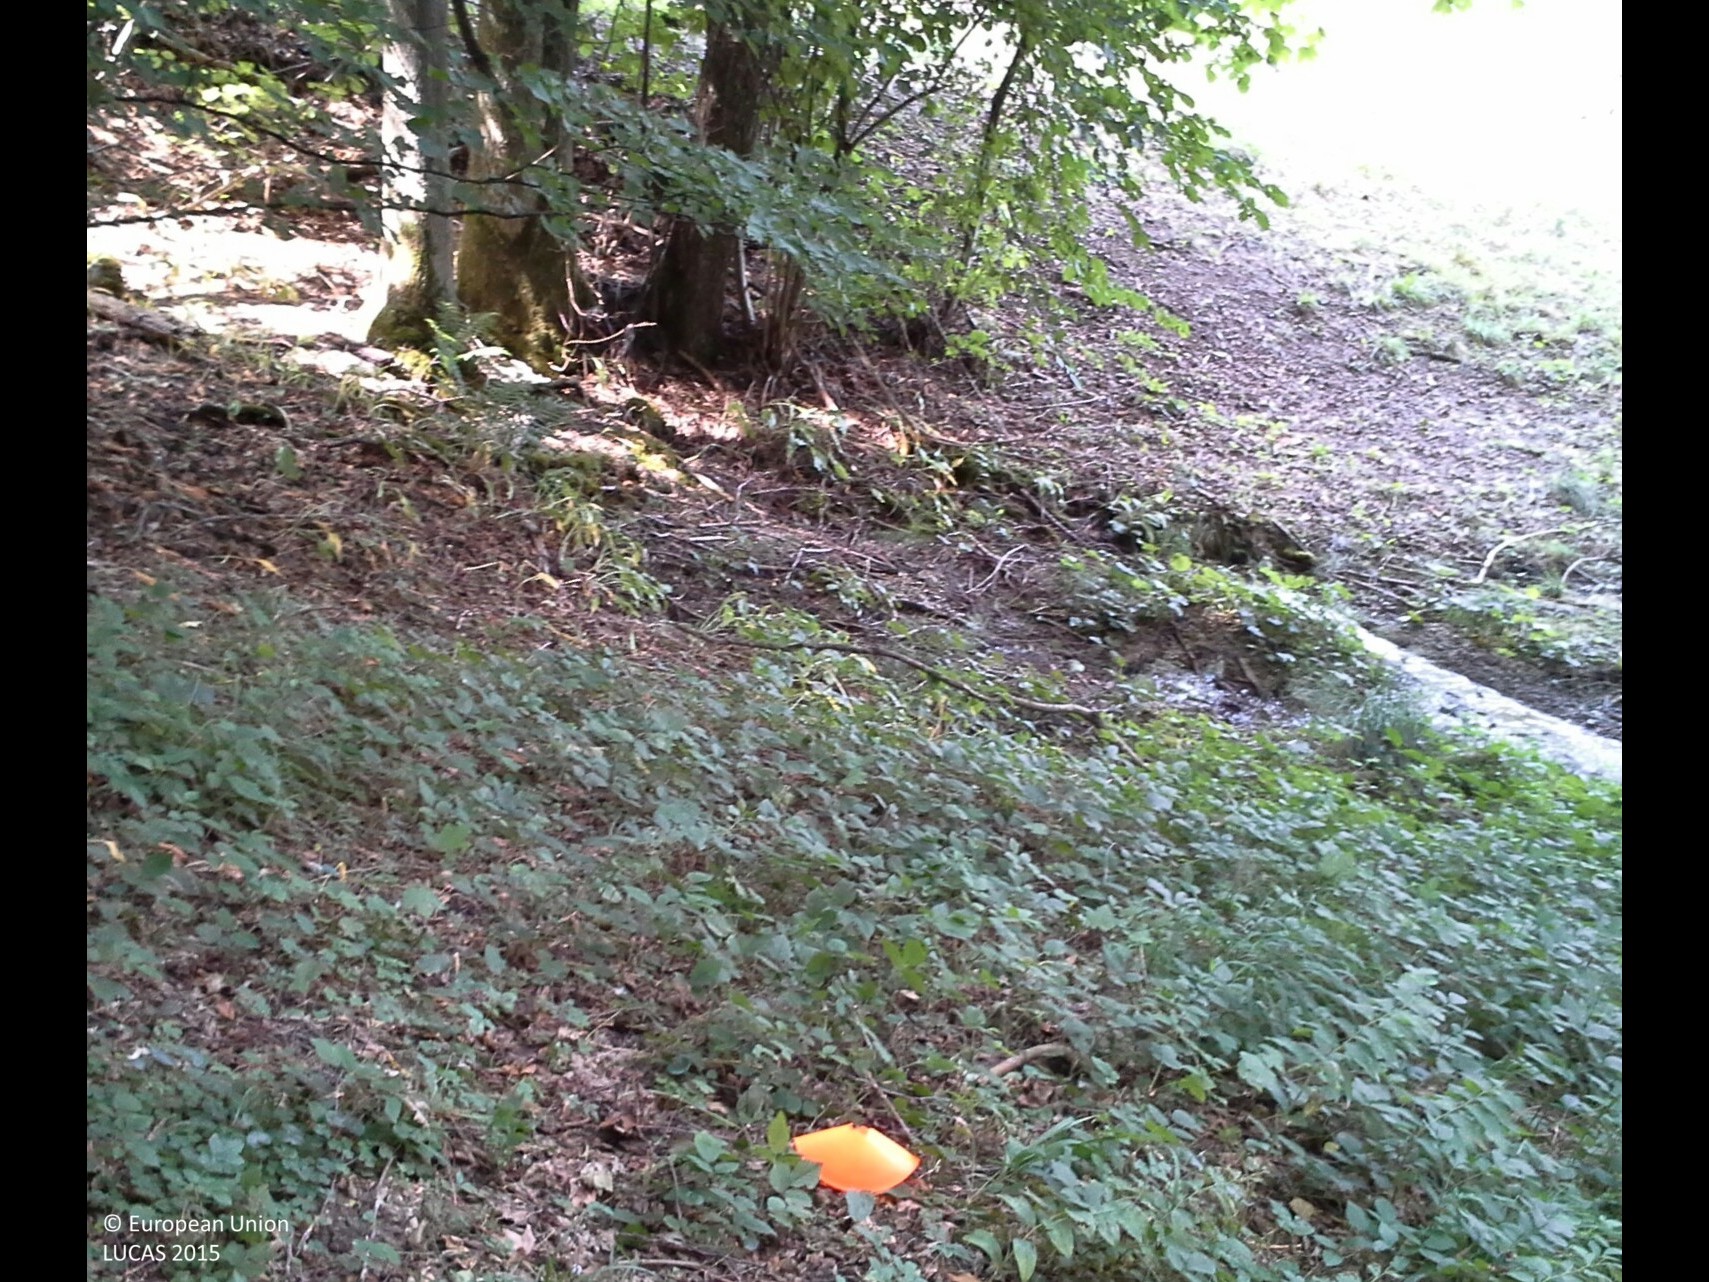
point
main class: Woodland
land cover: Broadleaved woodland
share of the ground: > 75 %
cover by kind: broadleaved forest trees 90 %, herbaceous plants 10 %
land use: Forestry
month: July
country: AT
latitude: 48.0241
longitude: 15.2980
